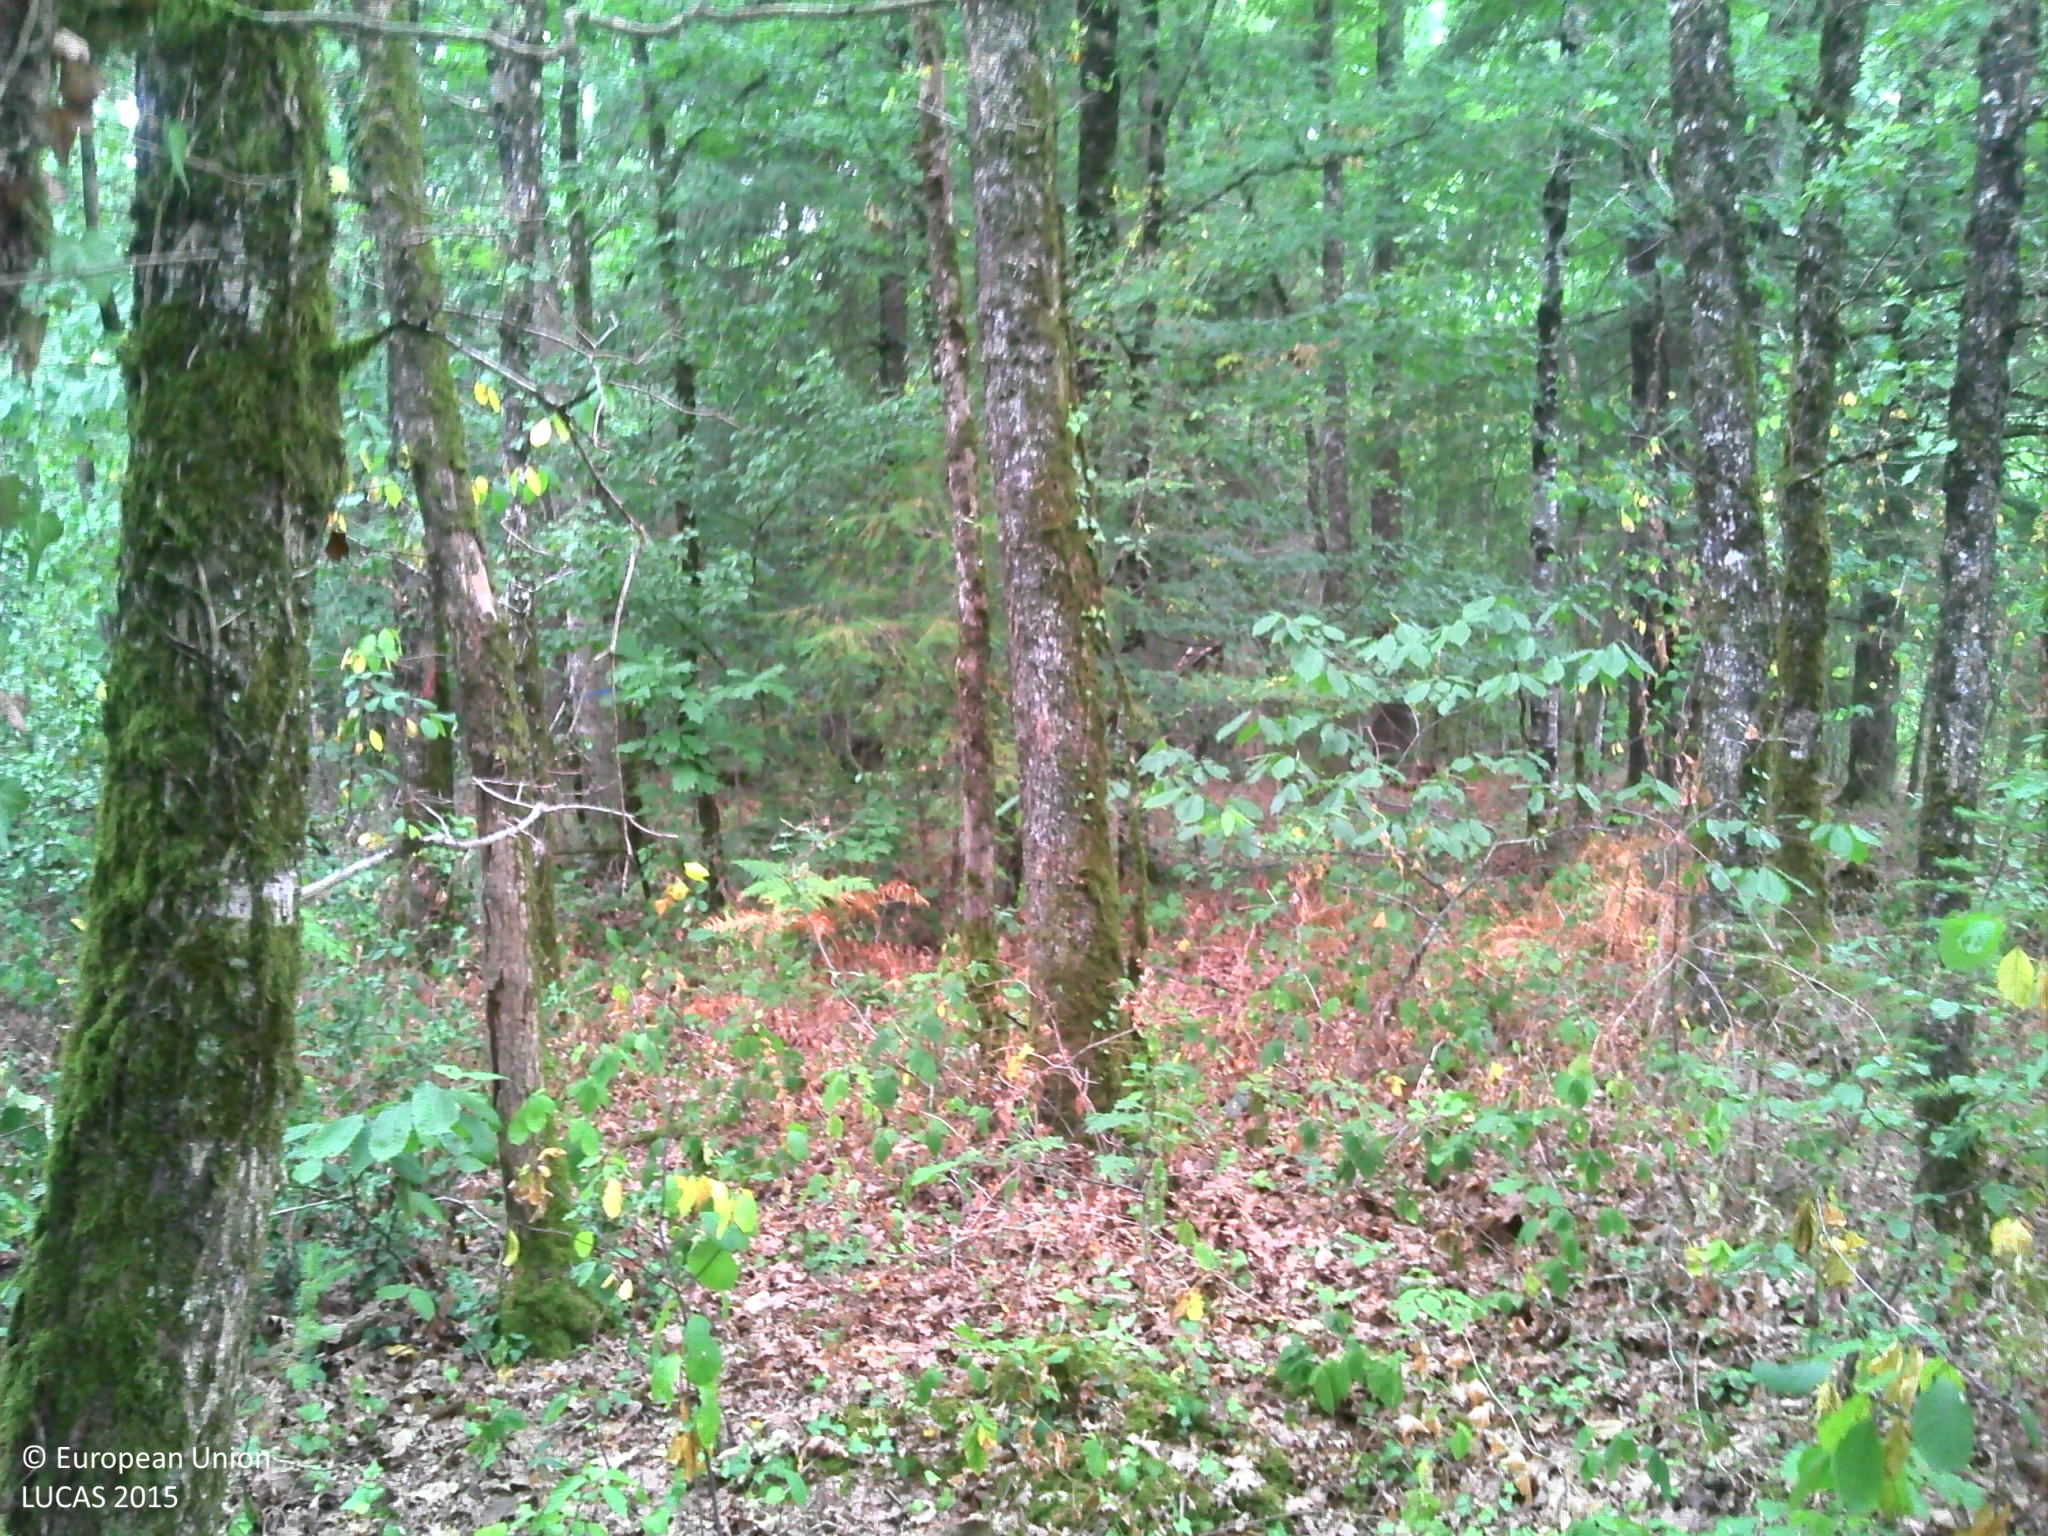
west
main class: Woodland
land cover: Broadleaved woodland
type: acidophilous oak and oak-birch forest
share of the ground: > 75 %
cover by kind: broadleaved forest trees 60 %, herbaceous plants 20 %, lichens and mosses 10 %, coniferous forest trees 5 %, shrubs 5 %
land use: Forestry
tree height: > 5 m
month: July
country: FR
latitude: 45.3126
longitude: 1.3582
